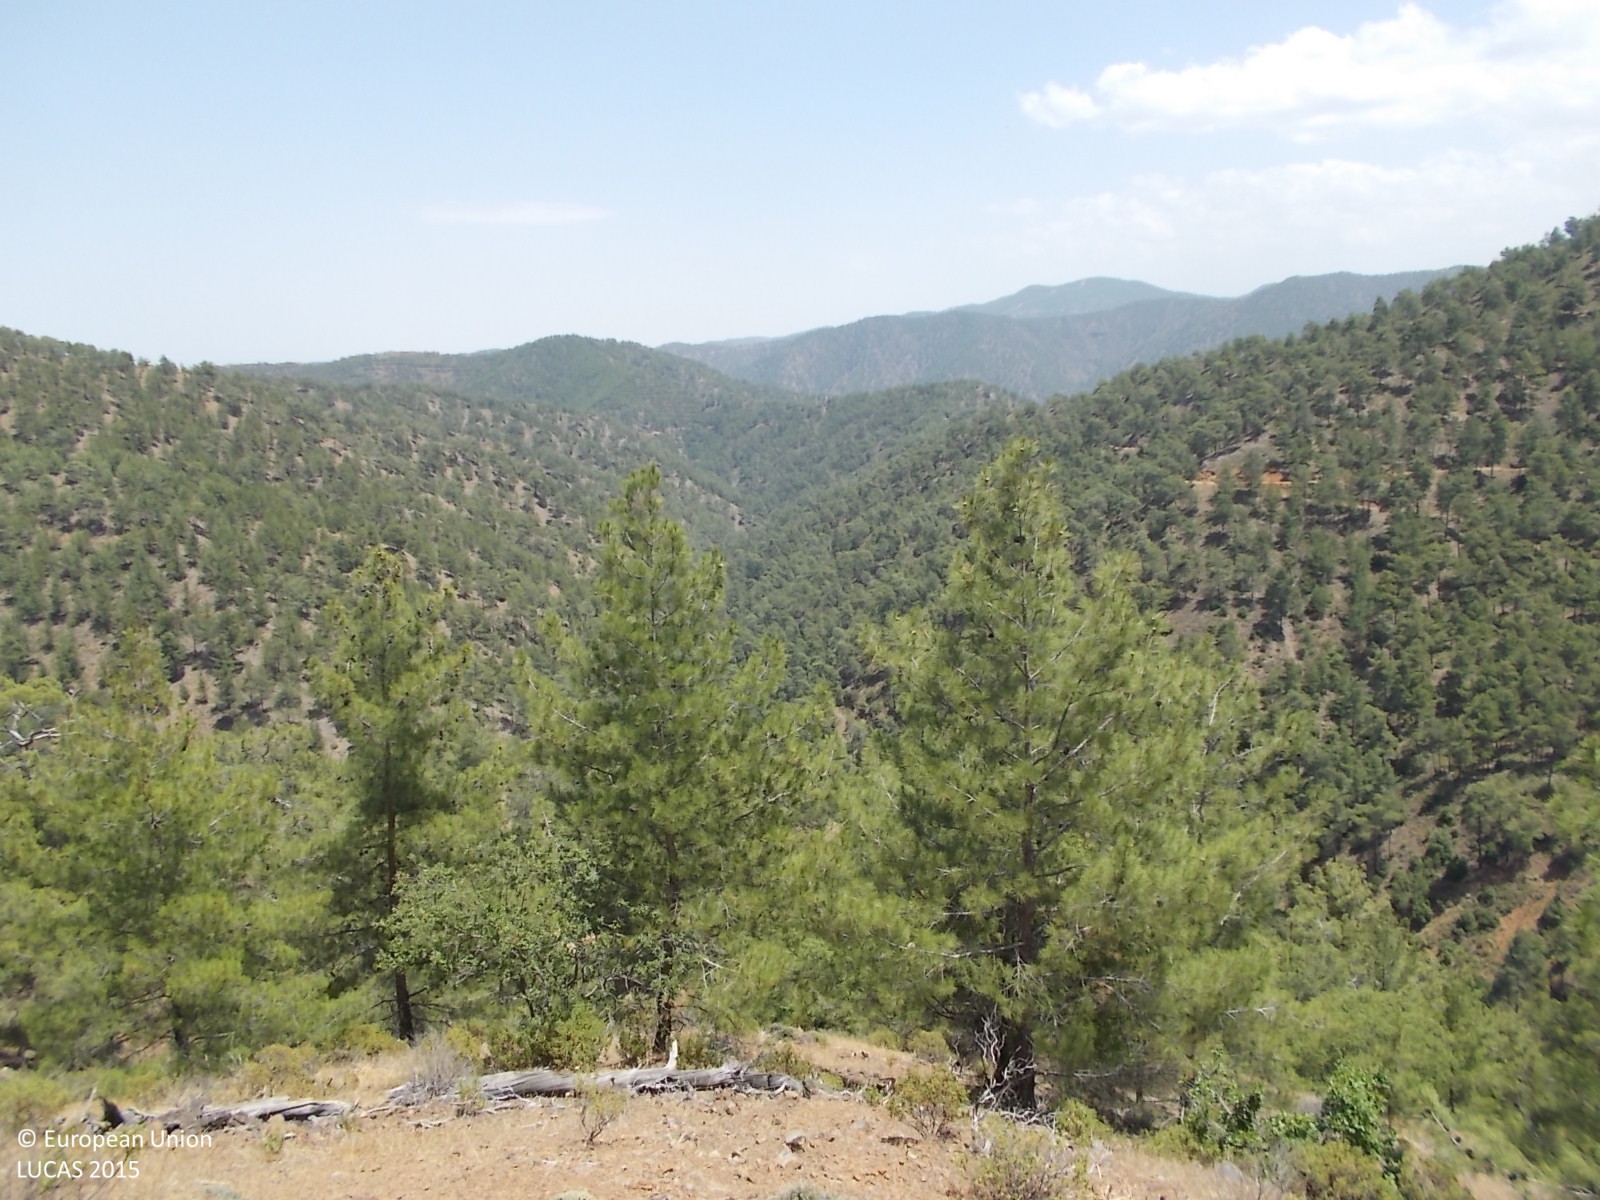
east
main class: Woodland
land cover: Pine dominated coniferous woodland
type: coniferous forest of the mediterranean region
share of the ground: 25 - 50 %
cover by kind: coniferous forest trees 40 %, unconsolidated bare surface 40 %, shrubs 20 %
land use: Forestry
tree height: > 5 m
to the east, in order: Pine dominated coniferous woodland; Shrubland with sparse tree cover; Pine dominated coniferous woodland
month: June
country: CY
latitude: 35.1090
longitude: 32.6441
